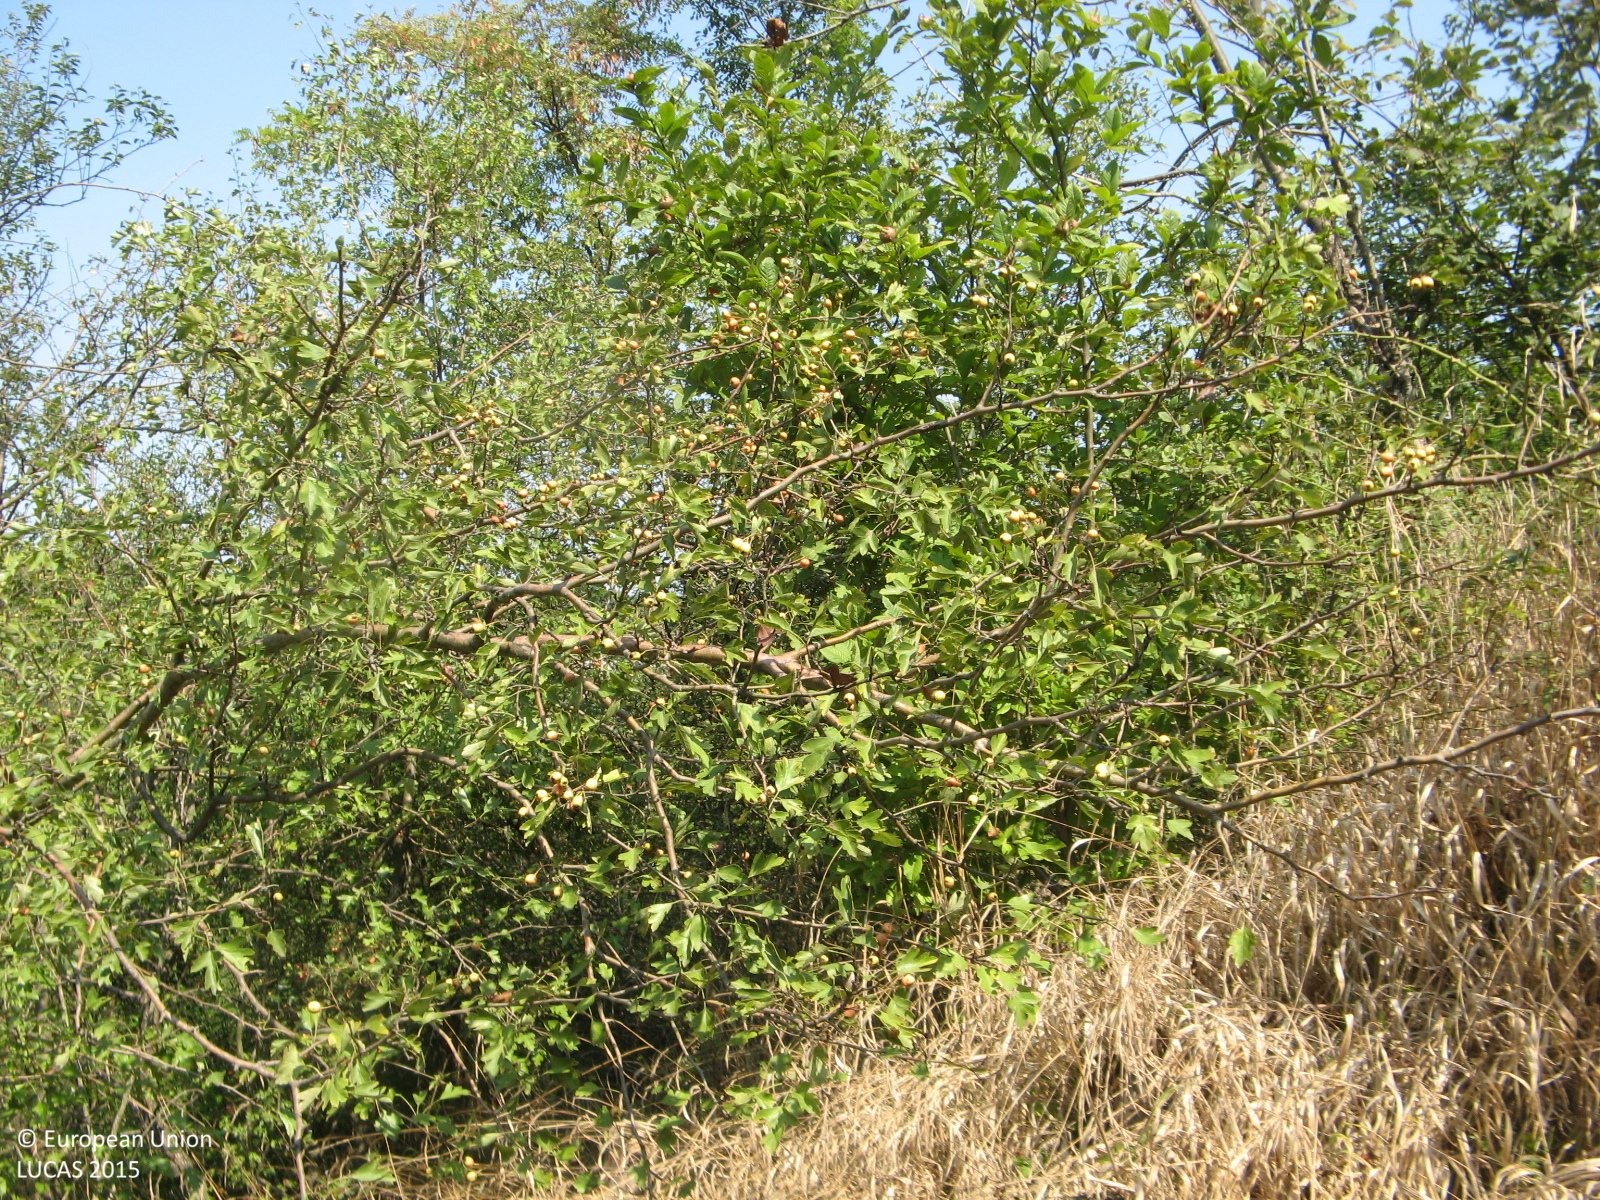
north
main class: Shrubland
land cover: Shrubland with sparse tree cover
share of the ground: > 75 %
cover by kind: shrubs 90 %, broadleaved forest trees 5 %, herbaceous plants 5 %
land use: Semi-natural and natural areas not in use
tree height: > 5 m
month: September
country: BG
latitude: 43.7608
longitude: 25.8800
